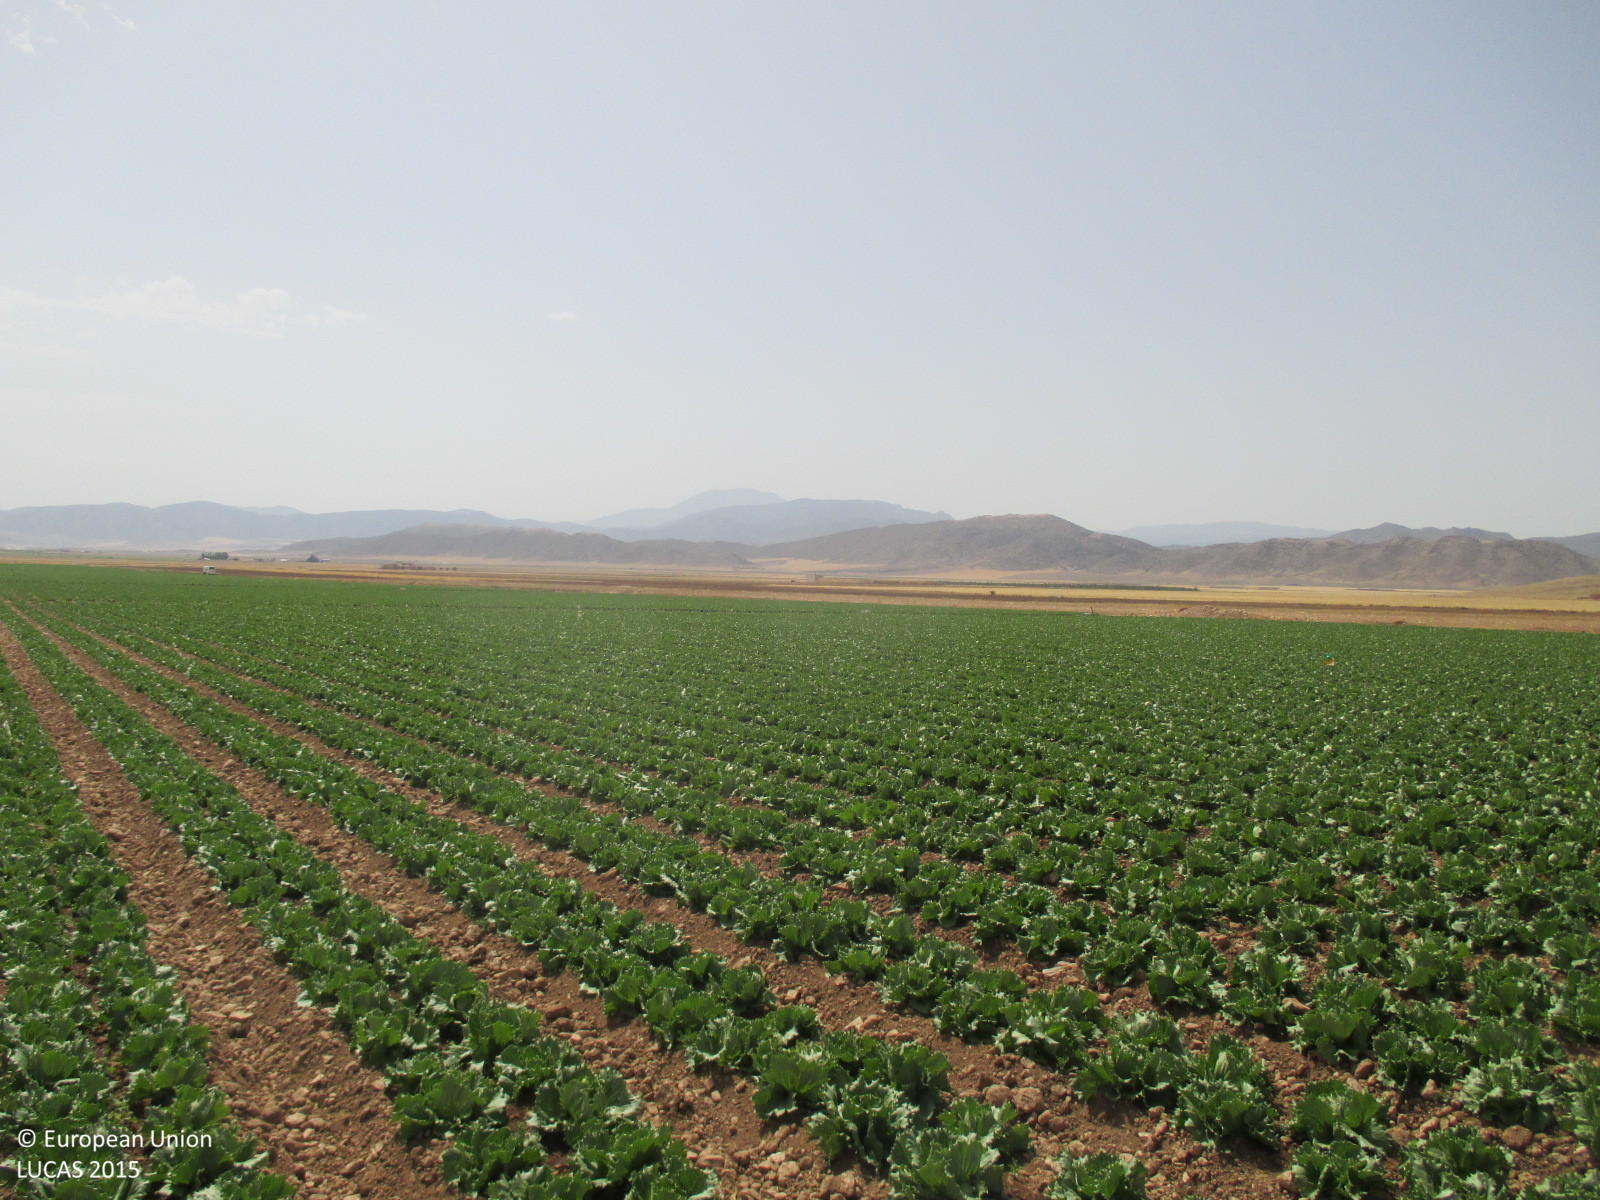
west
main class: Cropland
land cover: Other fresh vegetables
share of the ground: < 10 %
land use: Agriculture (excluding fallow land and kitchen gardens)
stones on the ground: 10 - 25 %
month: July
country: ES
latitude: 37.8977
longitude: -2.3055
